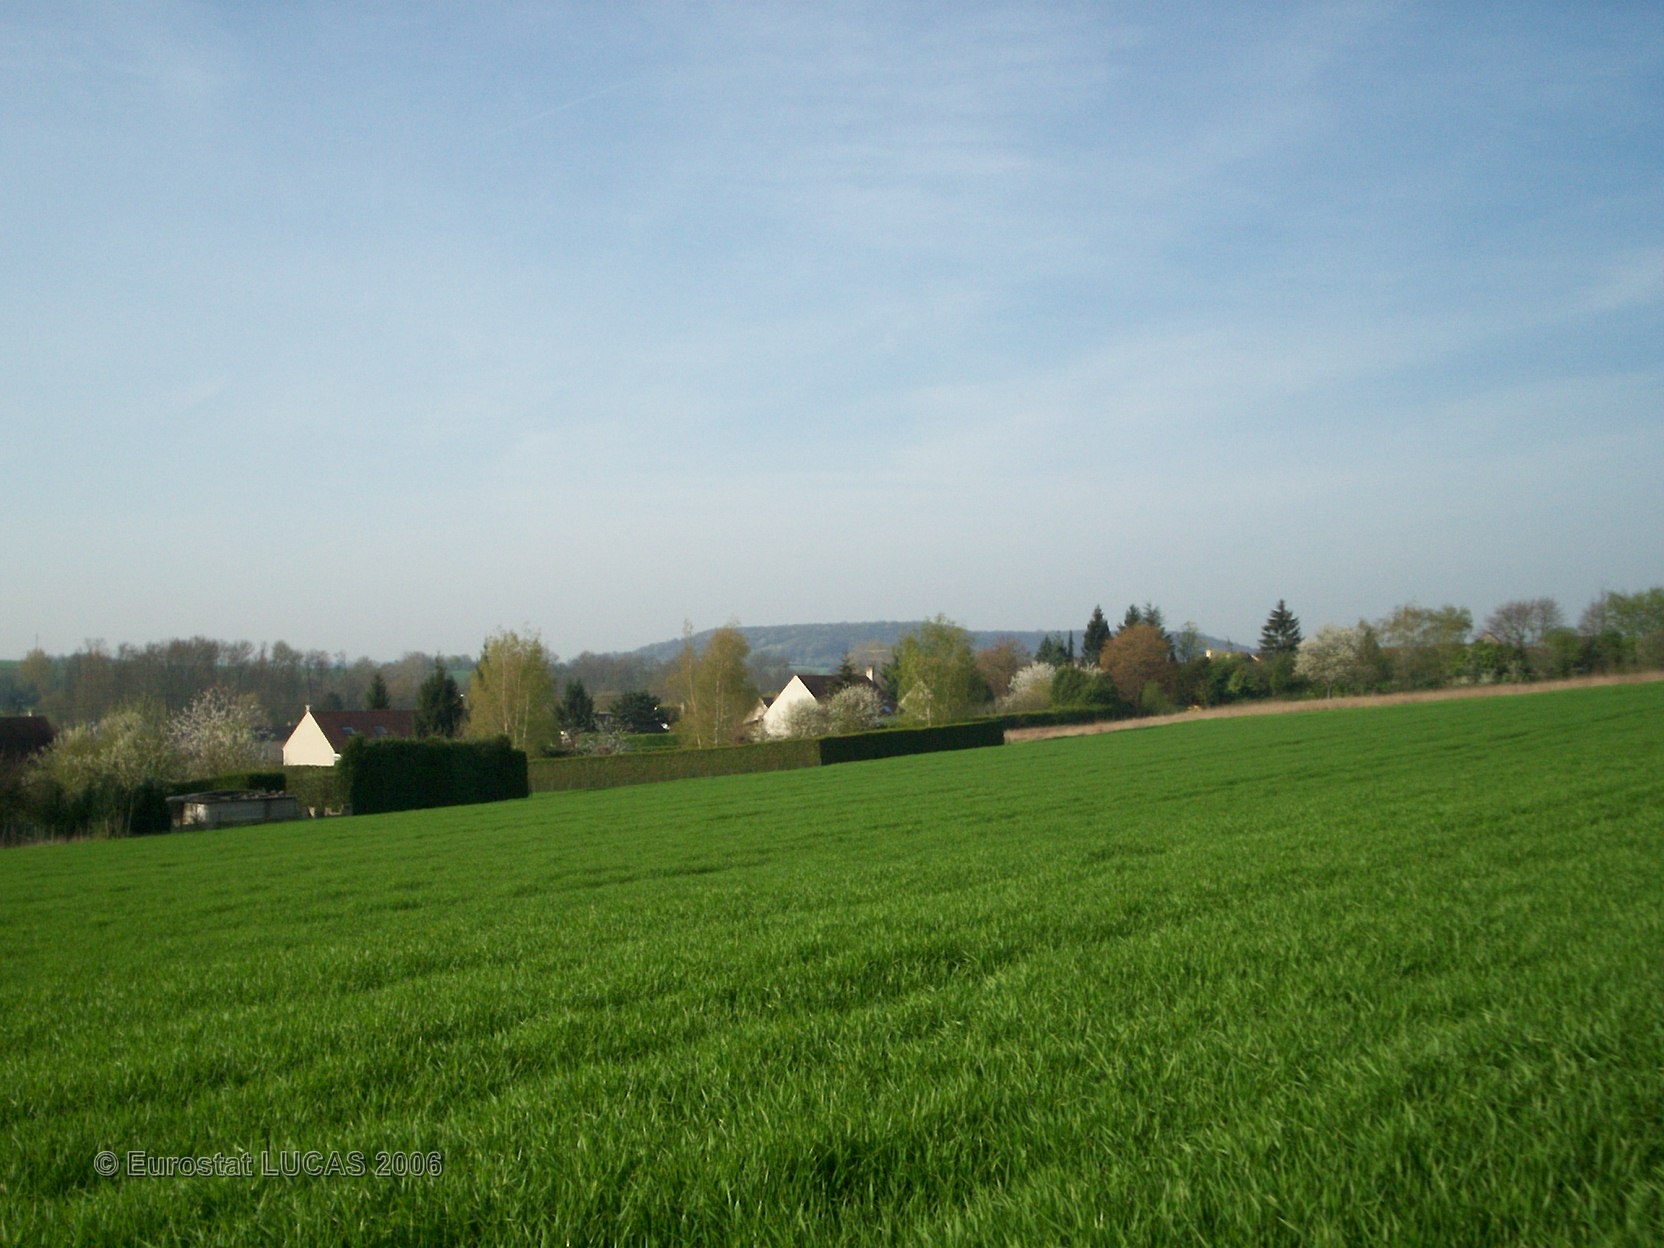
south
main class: Cropland
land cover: Barley
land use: Agriculture (excluding fallow land and kitchen gardens)
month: April
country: FR
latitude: 48.3527
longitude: 2.8528
